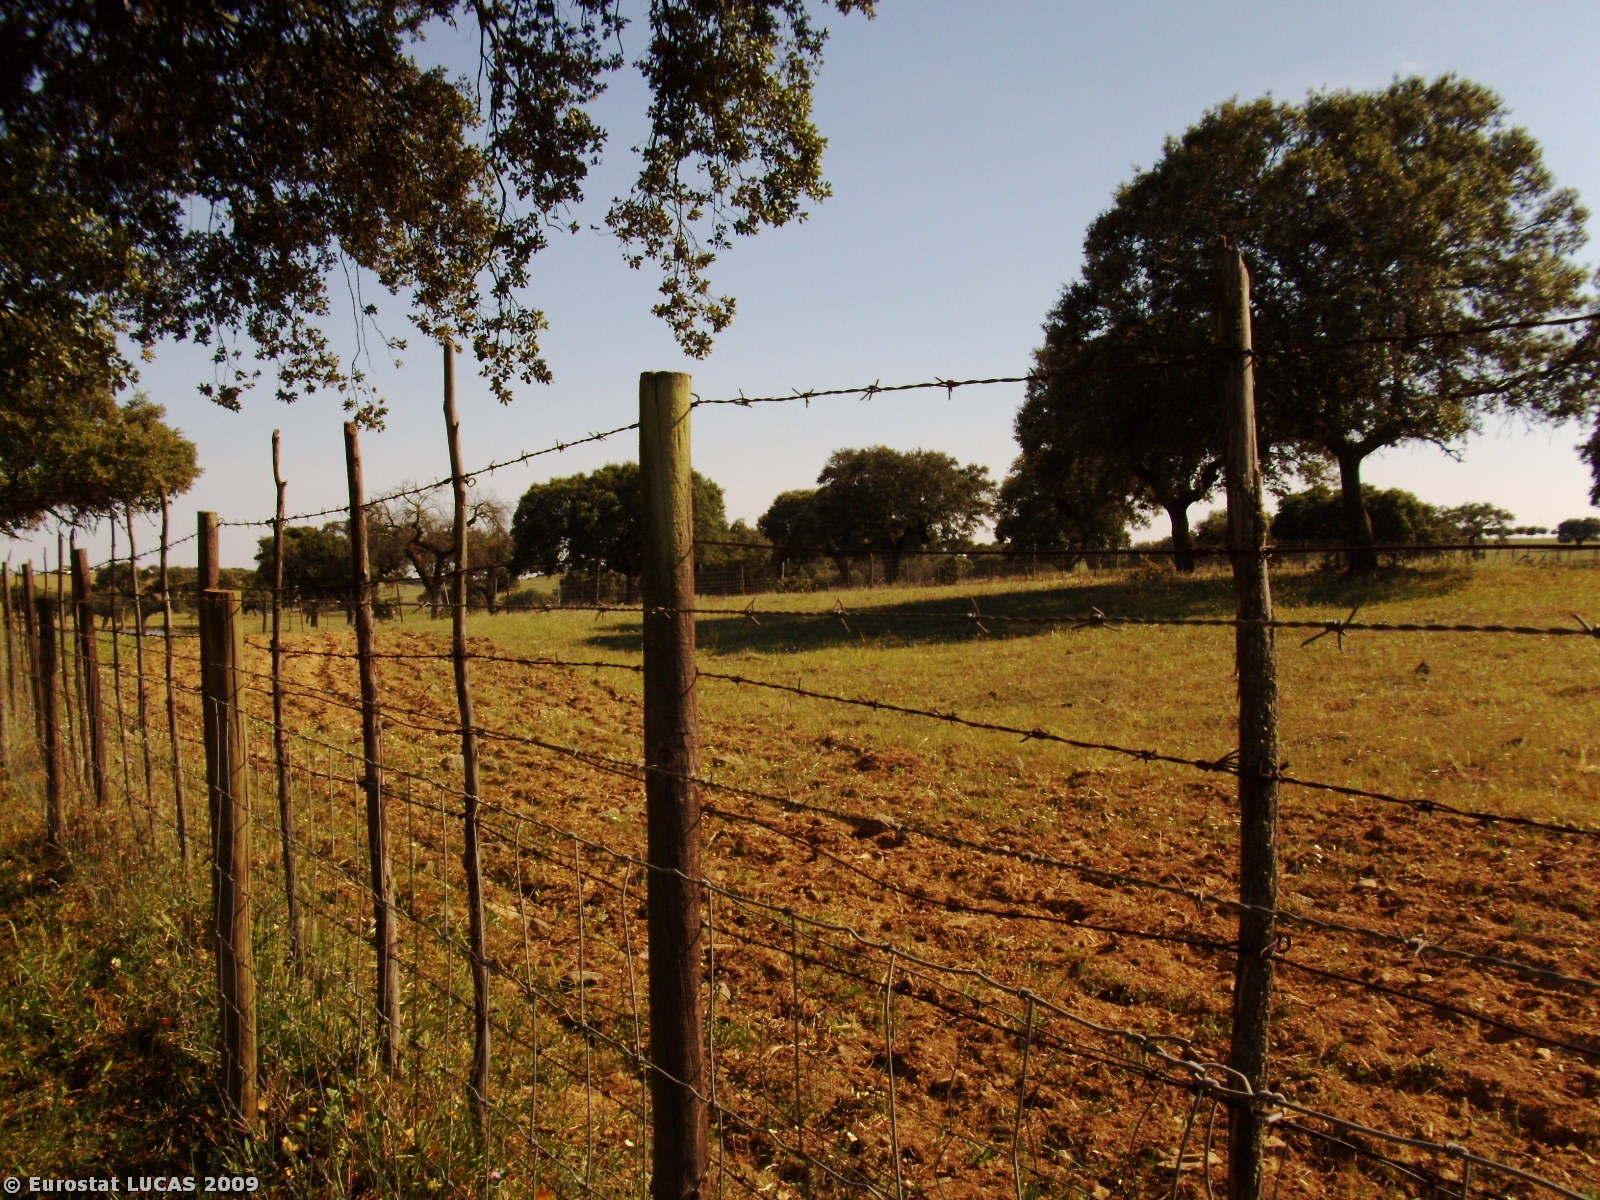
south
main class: Woodland
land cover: Broadleaved woodland
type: broadleaved evergreen forest
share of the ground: 25 - 50 %
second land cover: Spontaneously vegetated surfaces
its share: 50 - 75 %
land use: Agriculture (excluding fallow land and kitchen gardens)
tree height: > 5 m
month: May
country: PT
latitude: 38.8028
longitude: -7.3372
